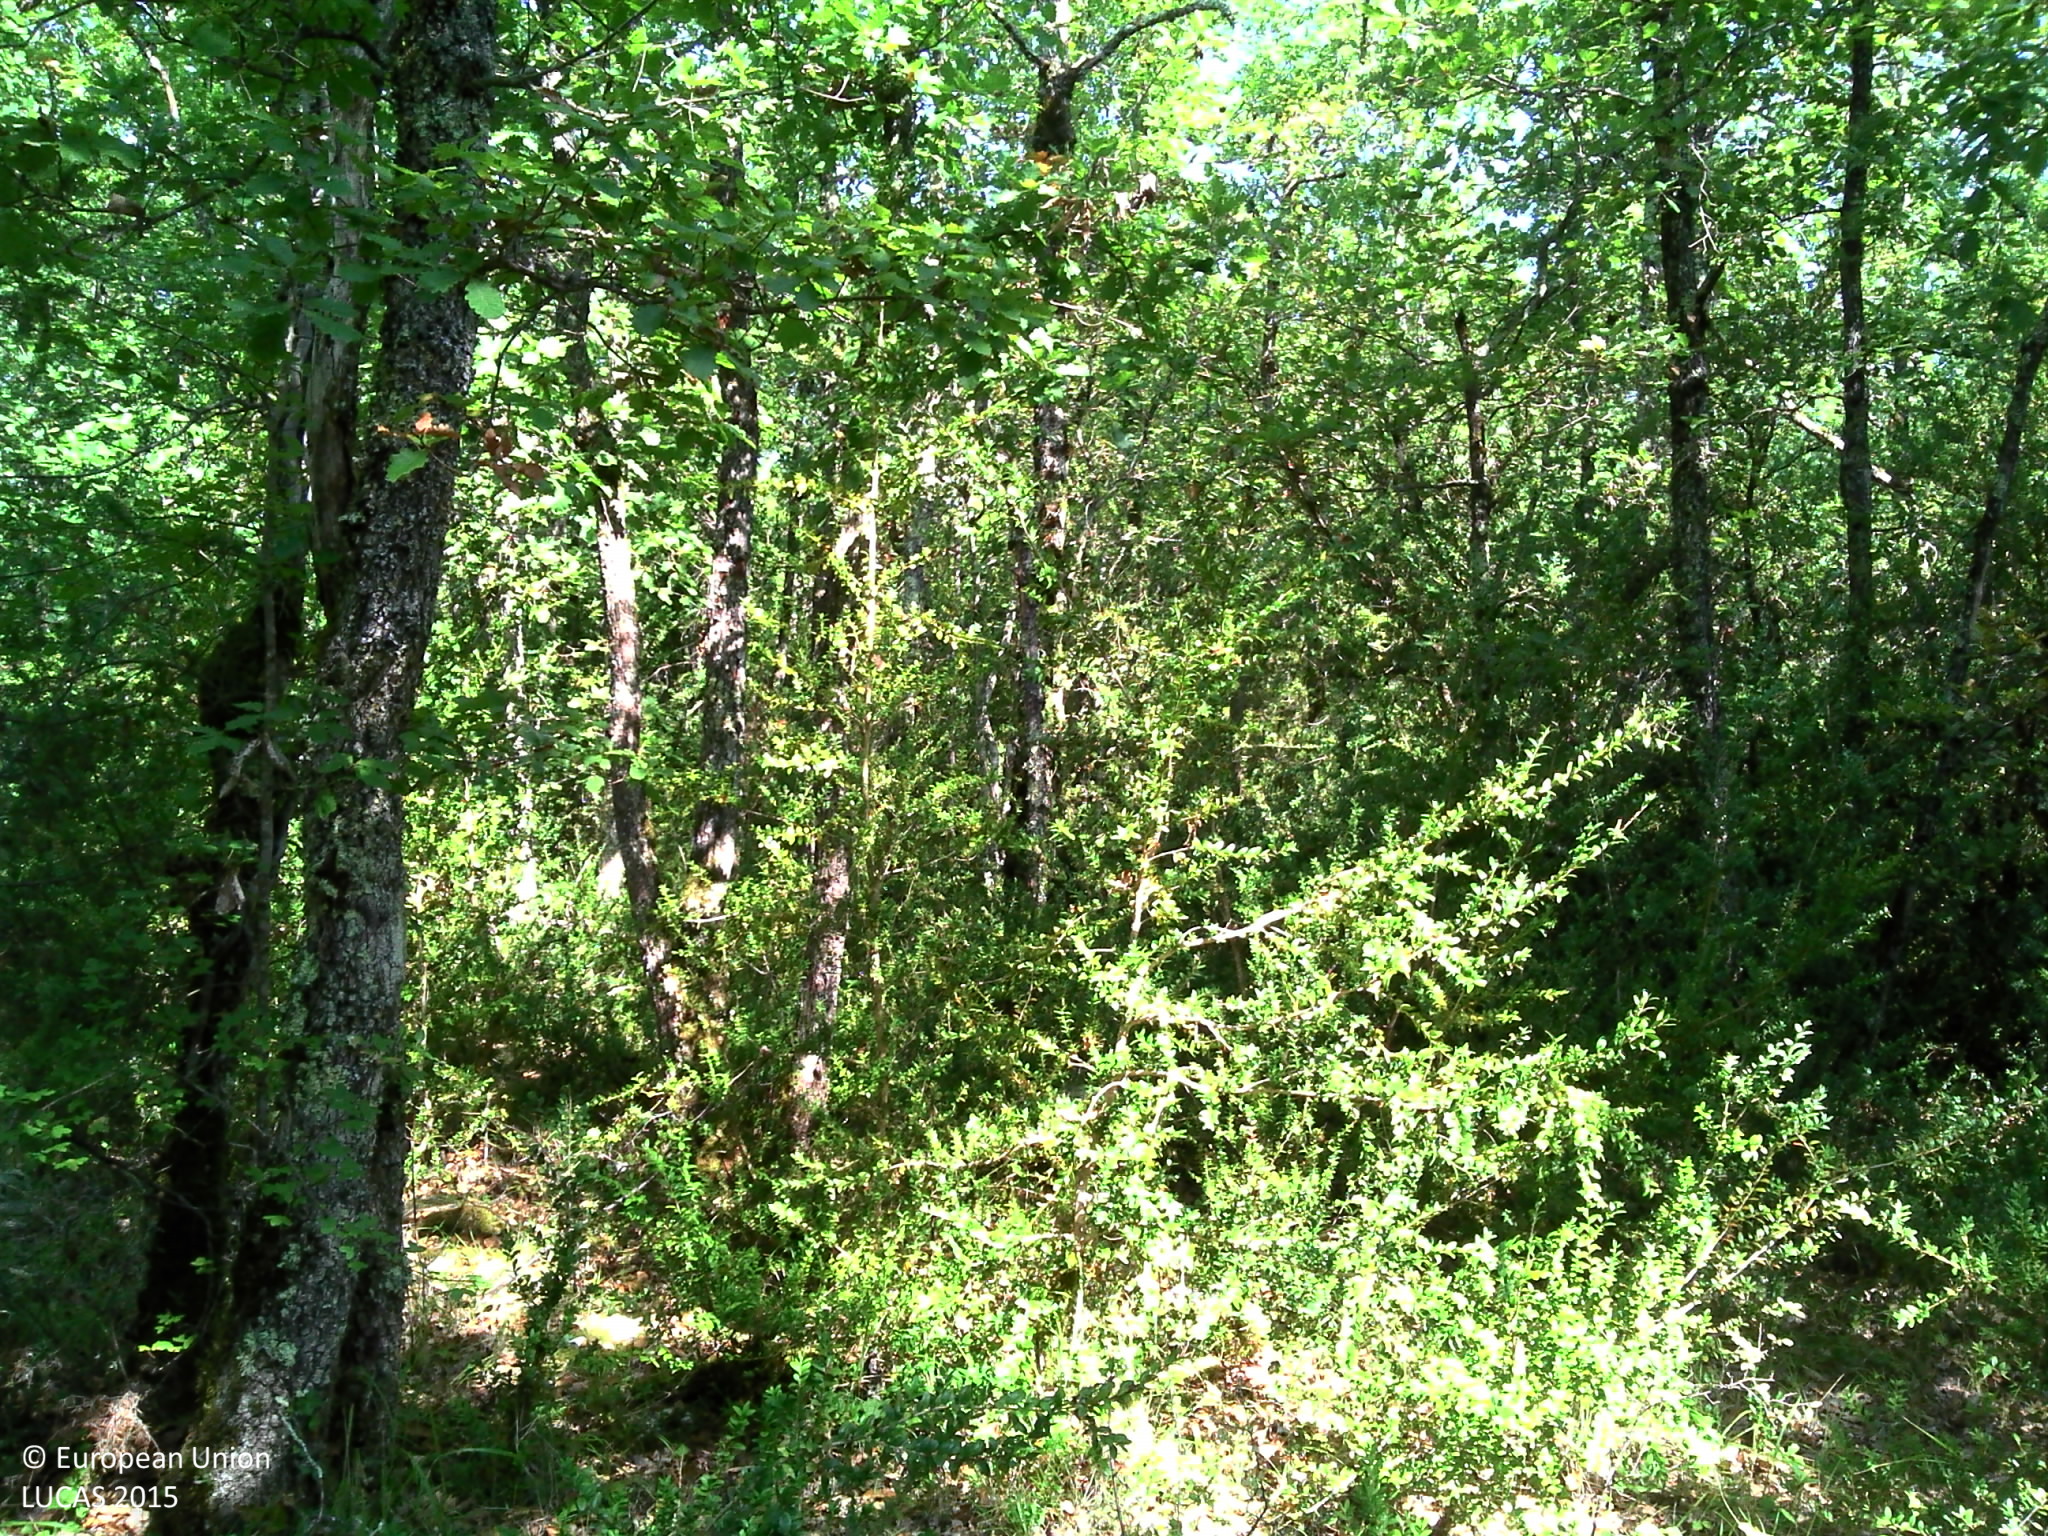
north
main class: Woodland
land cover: Broadleaved woodland
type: mesophytic deciduous forest
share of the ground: > 75 %
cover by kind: broadleaved forest trees 90 %, coniferous forest trees 10 %
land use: Agriculture (excluding fallow land and kitchen gardens)
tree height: > 5 m
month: August
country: FR
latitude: 44.2490
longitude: 1.6471
